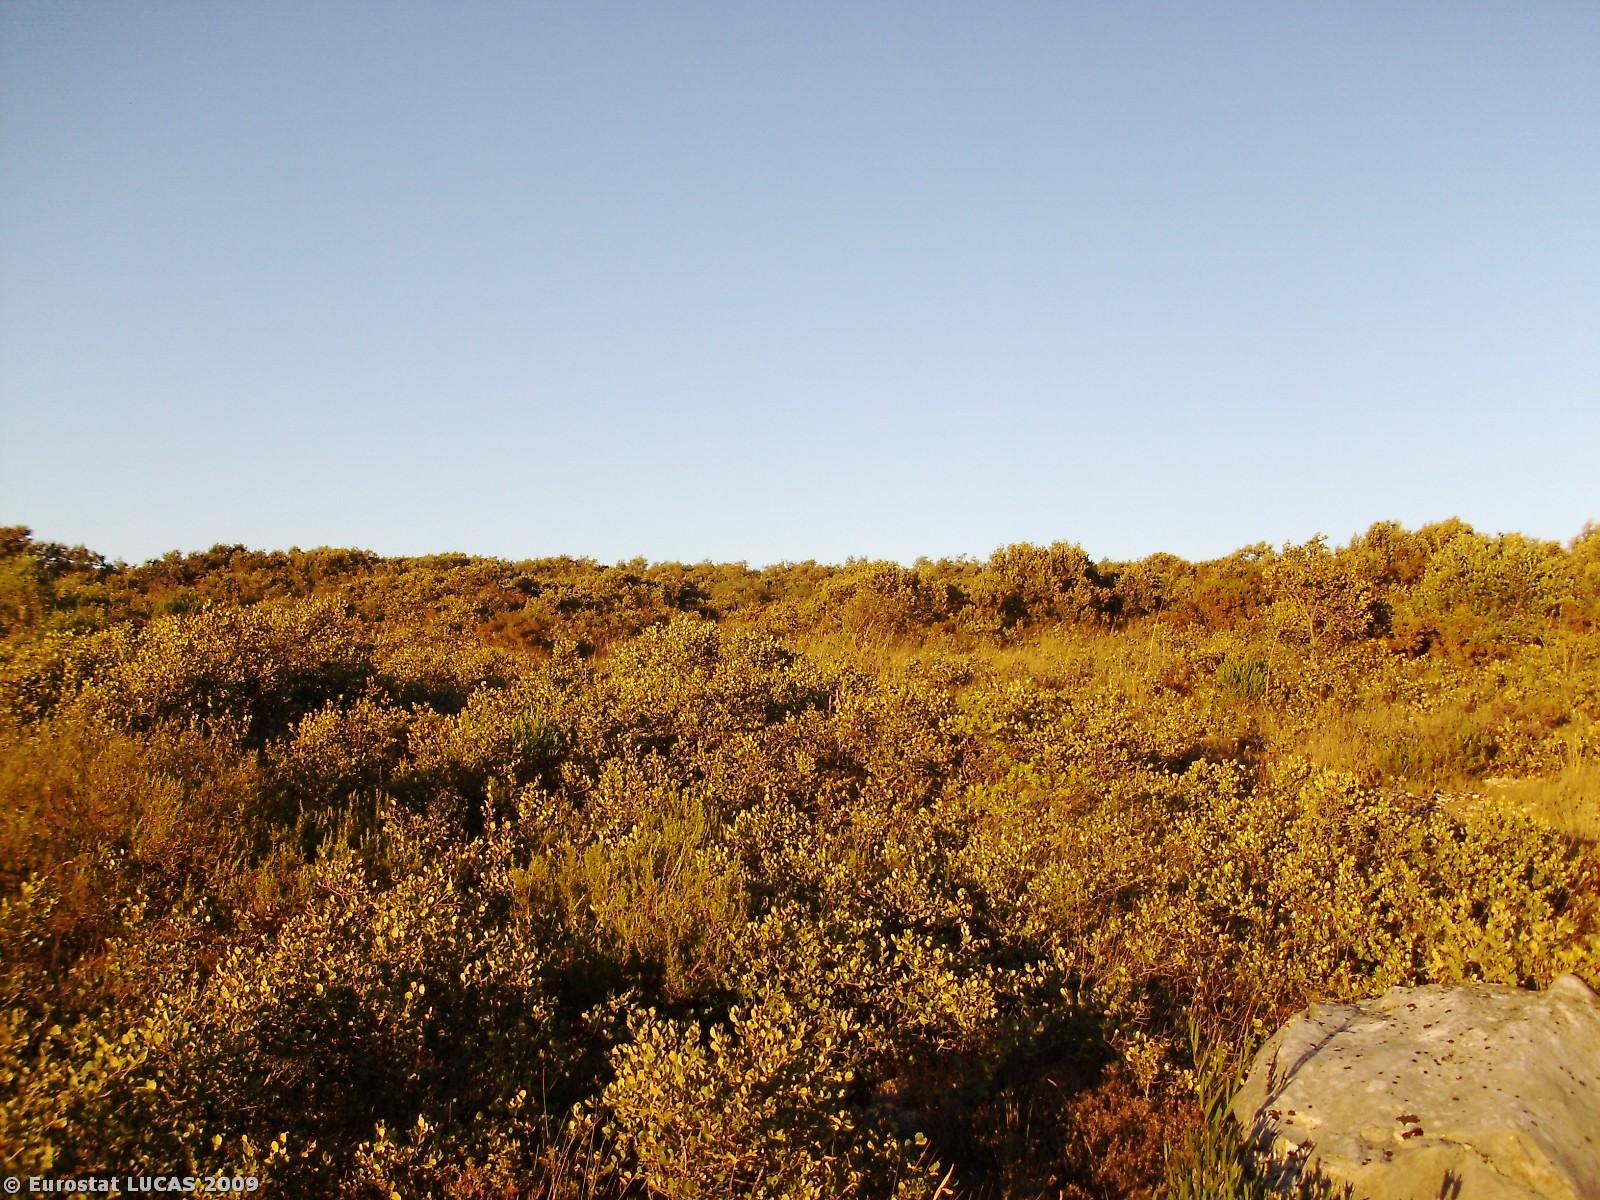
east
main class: Shrubland
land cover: Shrubland without tree cover
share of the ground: > 75 %
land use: Nature reserves
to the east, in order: Shrubland without tree cover; Tracks; Shrubland without tree cover; Tracks; Shrubland without tree cover; Paved roads, cycling and walking lanes; Shrubland without tree cover
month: July
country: PT
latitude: 39.4671
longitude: -8.8059
